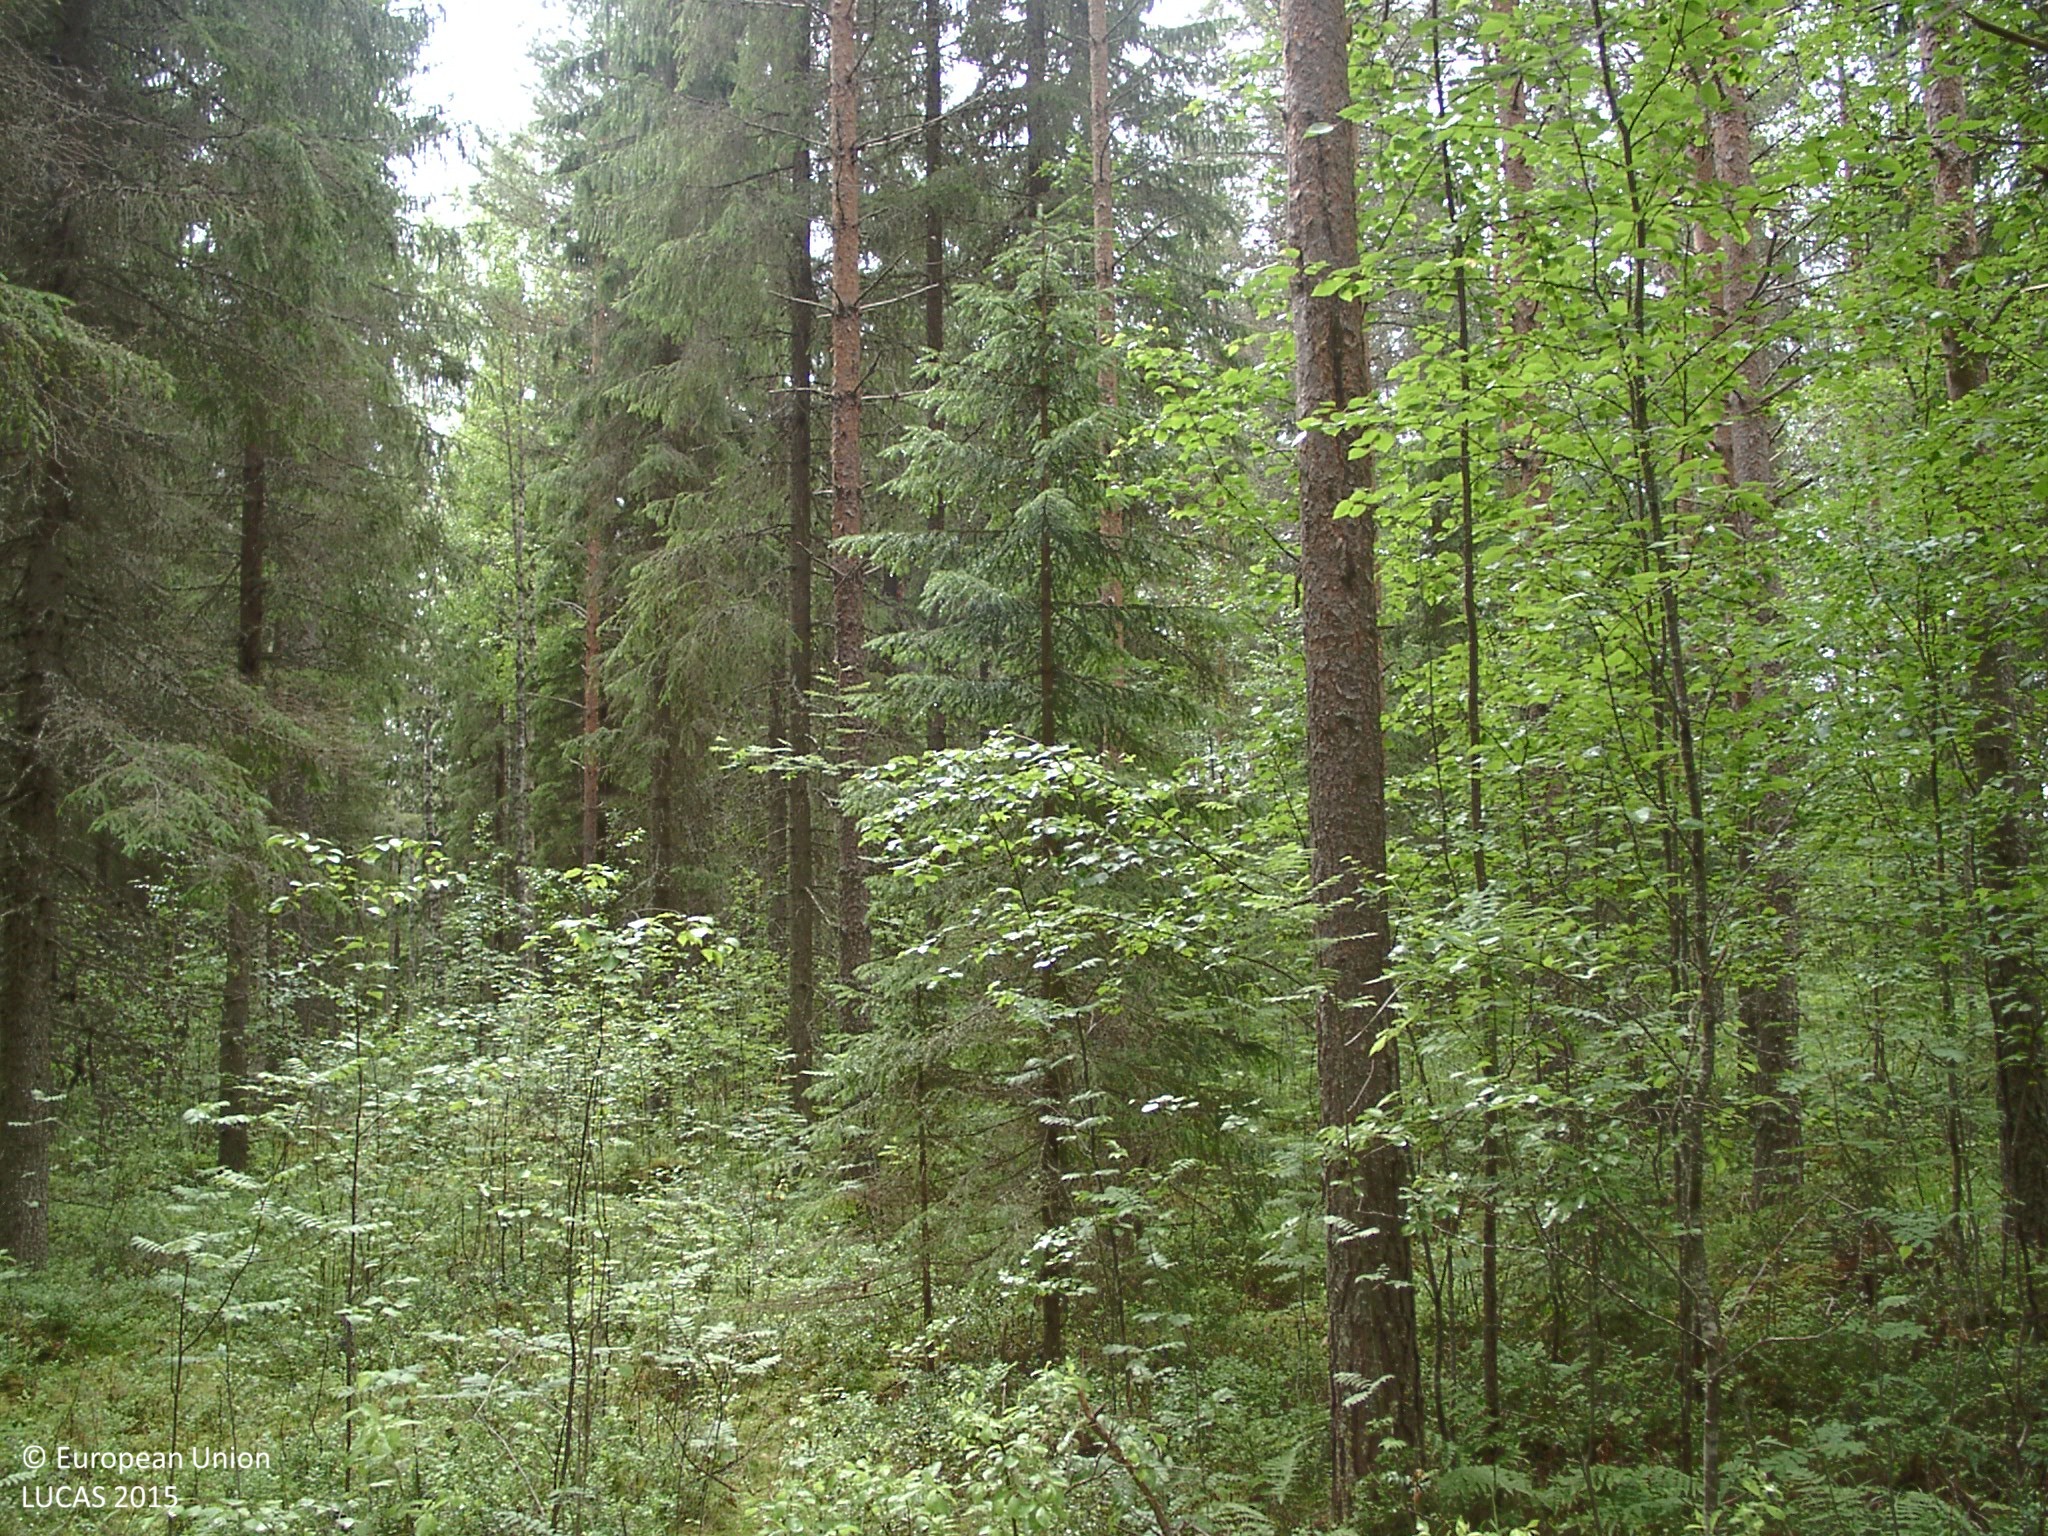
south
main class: Woodland
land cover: Other mixed woodland
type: boreal forest
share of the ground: 50 - 75 %
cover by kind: coniferous forest trees 45 %, broadleaved forest trees 25 %, shrubs 20 %, lichens and mosses 10 %
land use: Forestry
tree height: > 5 m
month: July
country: FI
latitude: 61.6456
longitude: 24.8847
